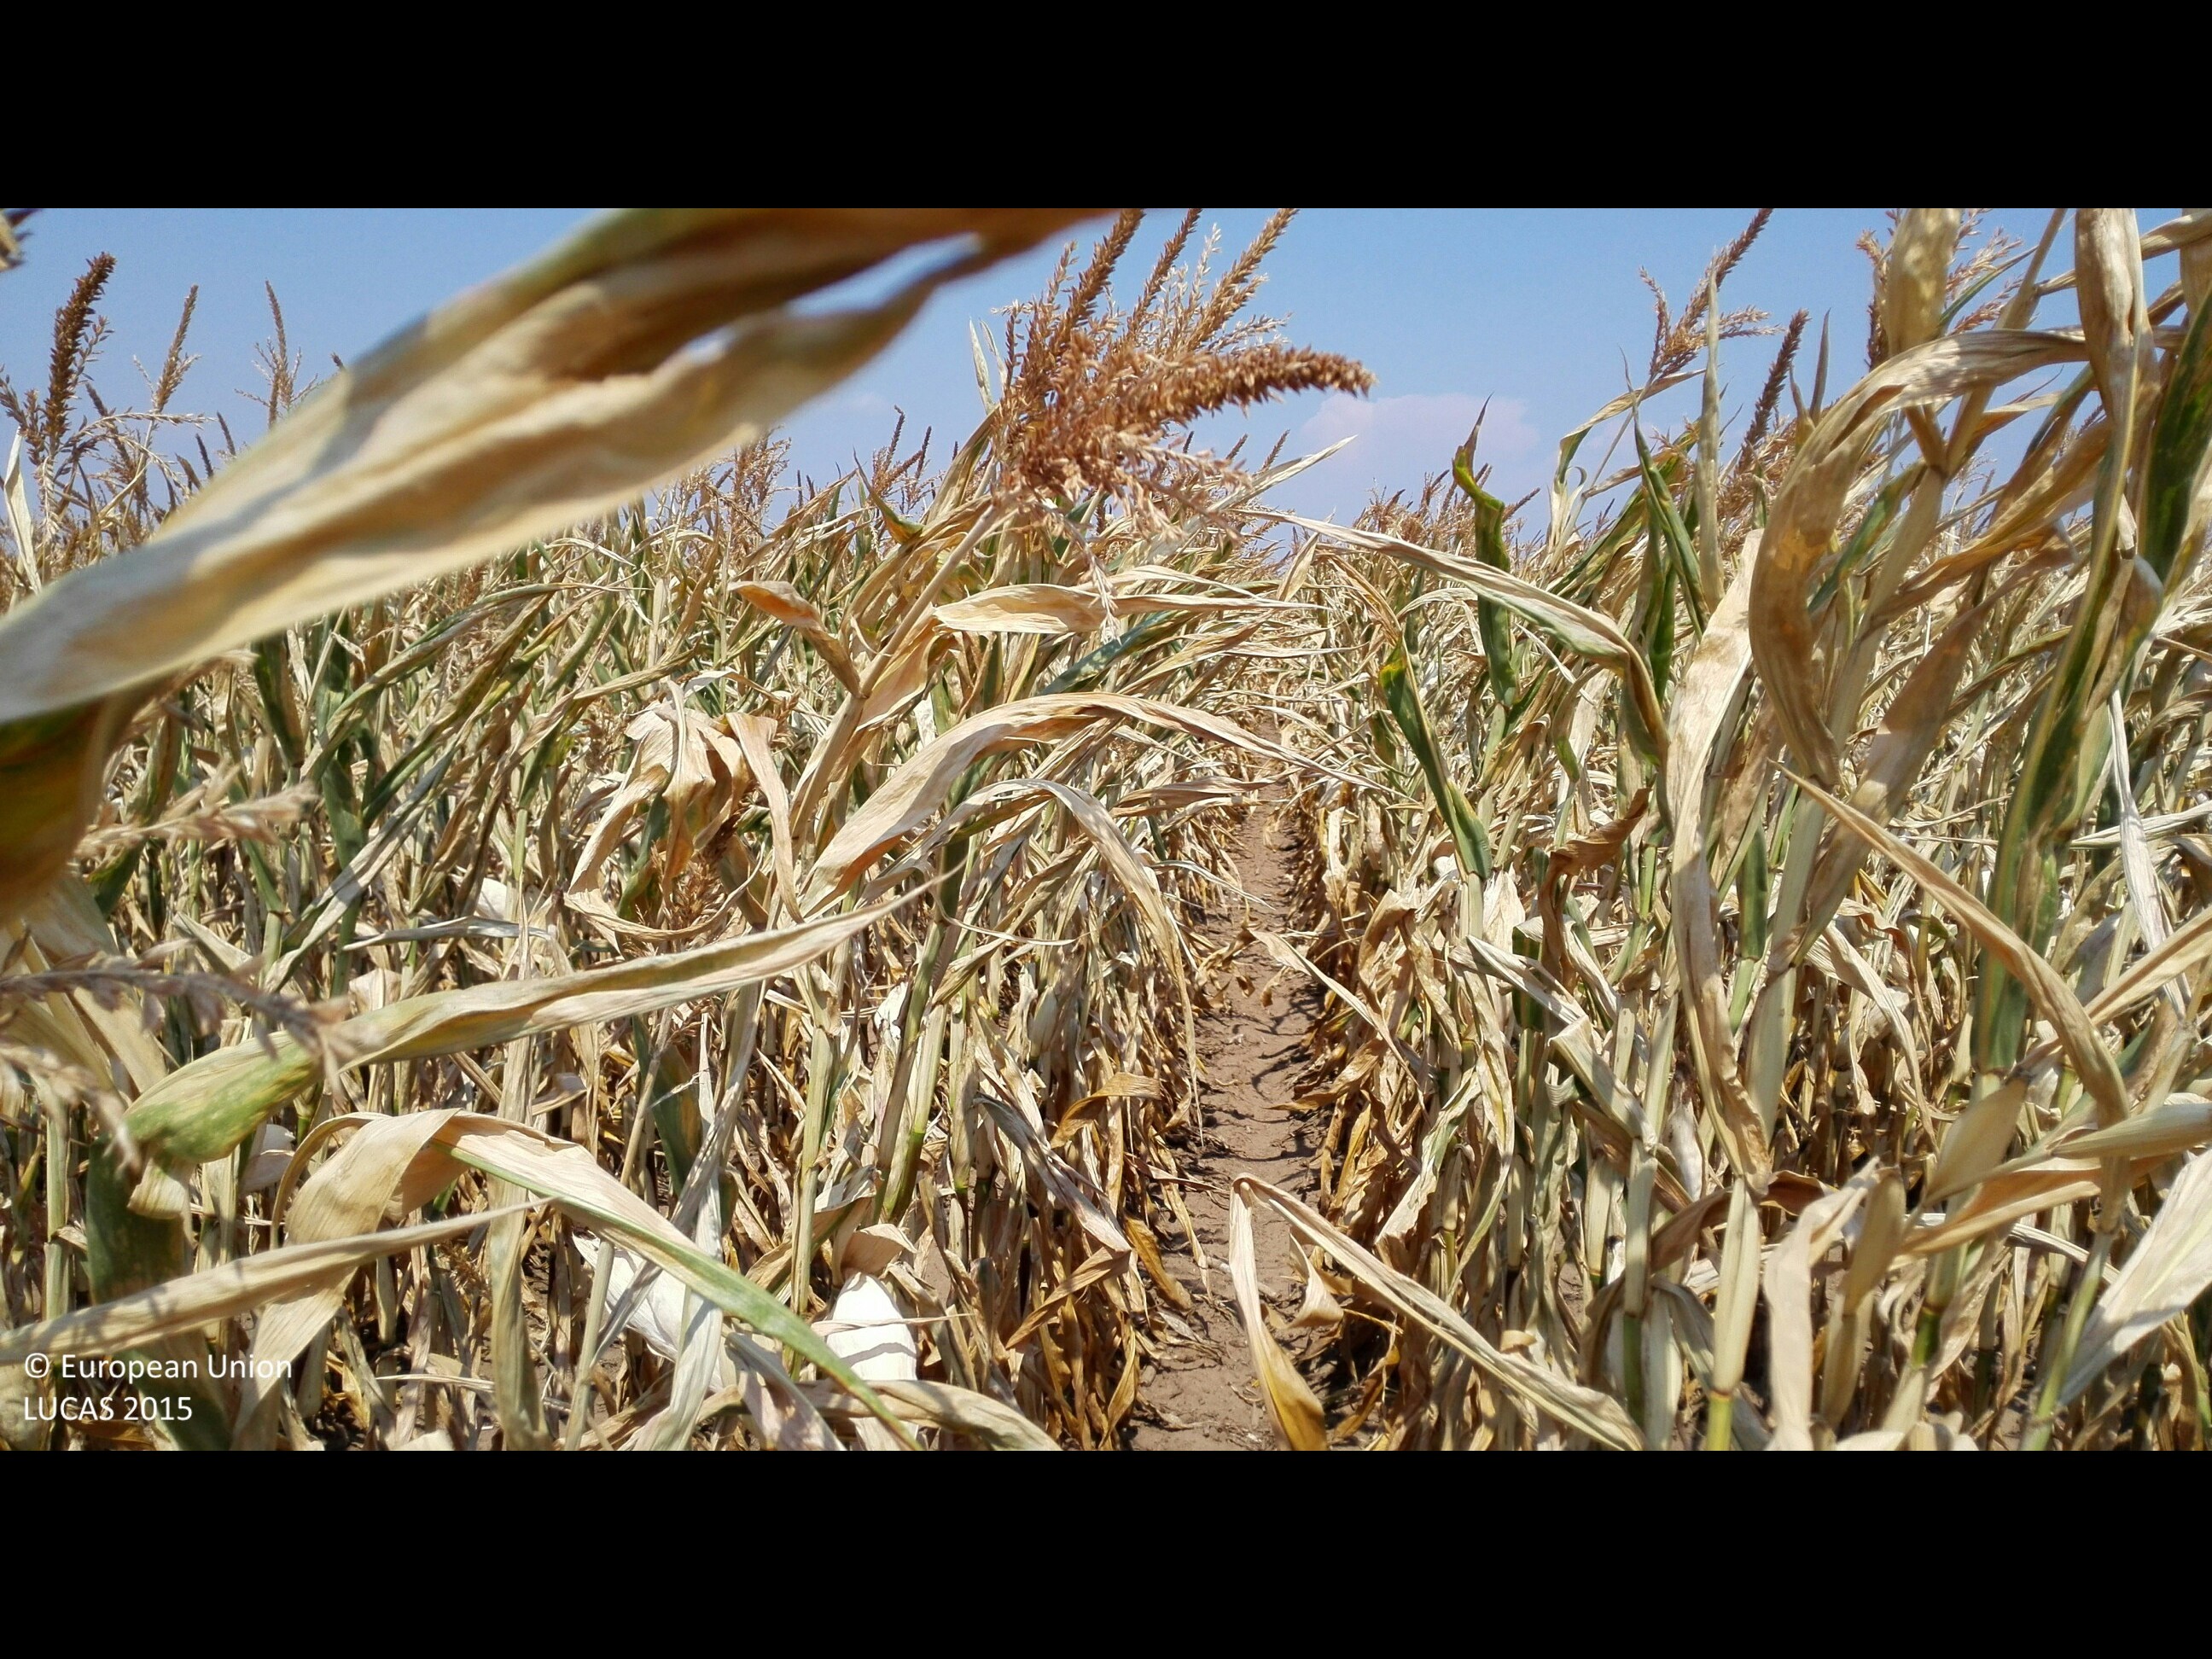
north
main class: Cropland
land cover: Maize
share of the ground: > 75 %
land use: Agriculture (excluding fallow land and kitchen gardens)
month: August
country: HU
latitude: 47.4075
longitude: 21.6129
